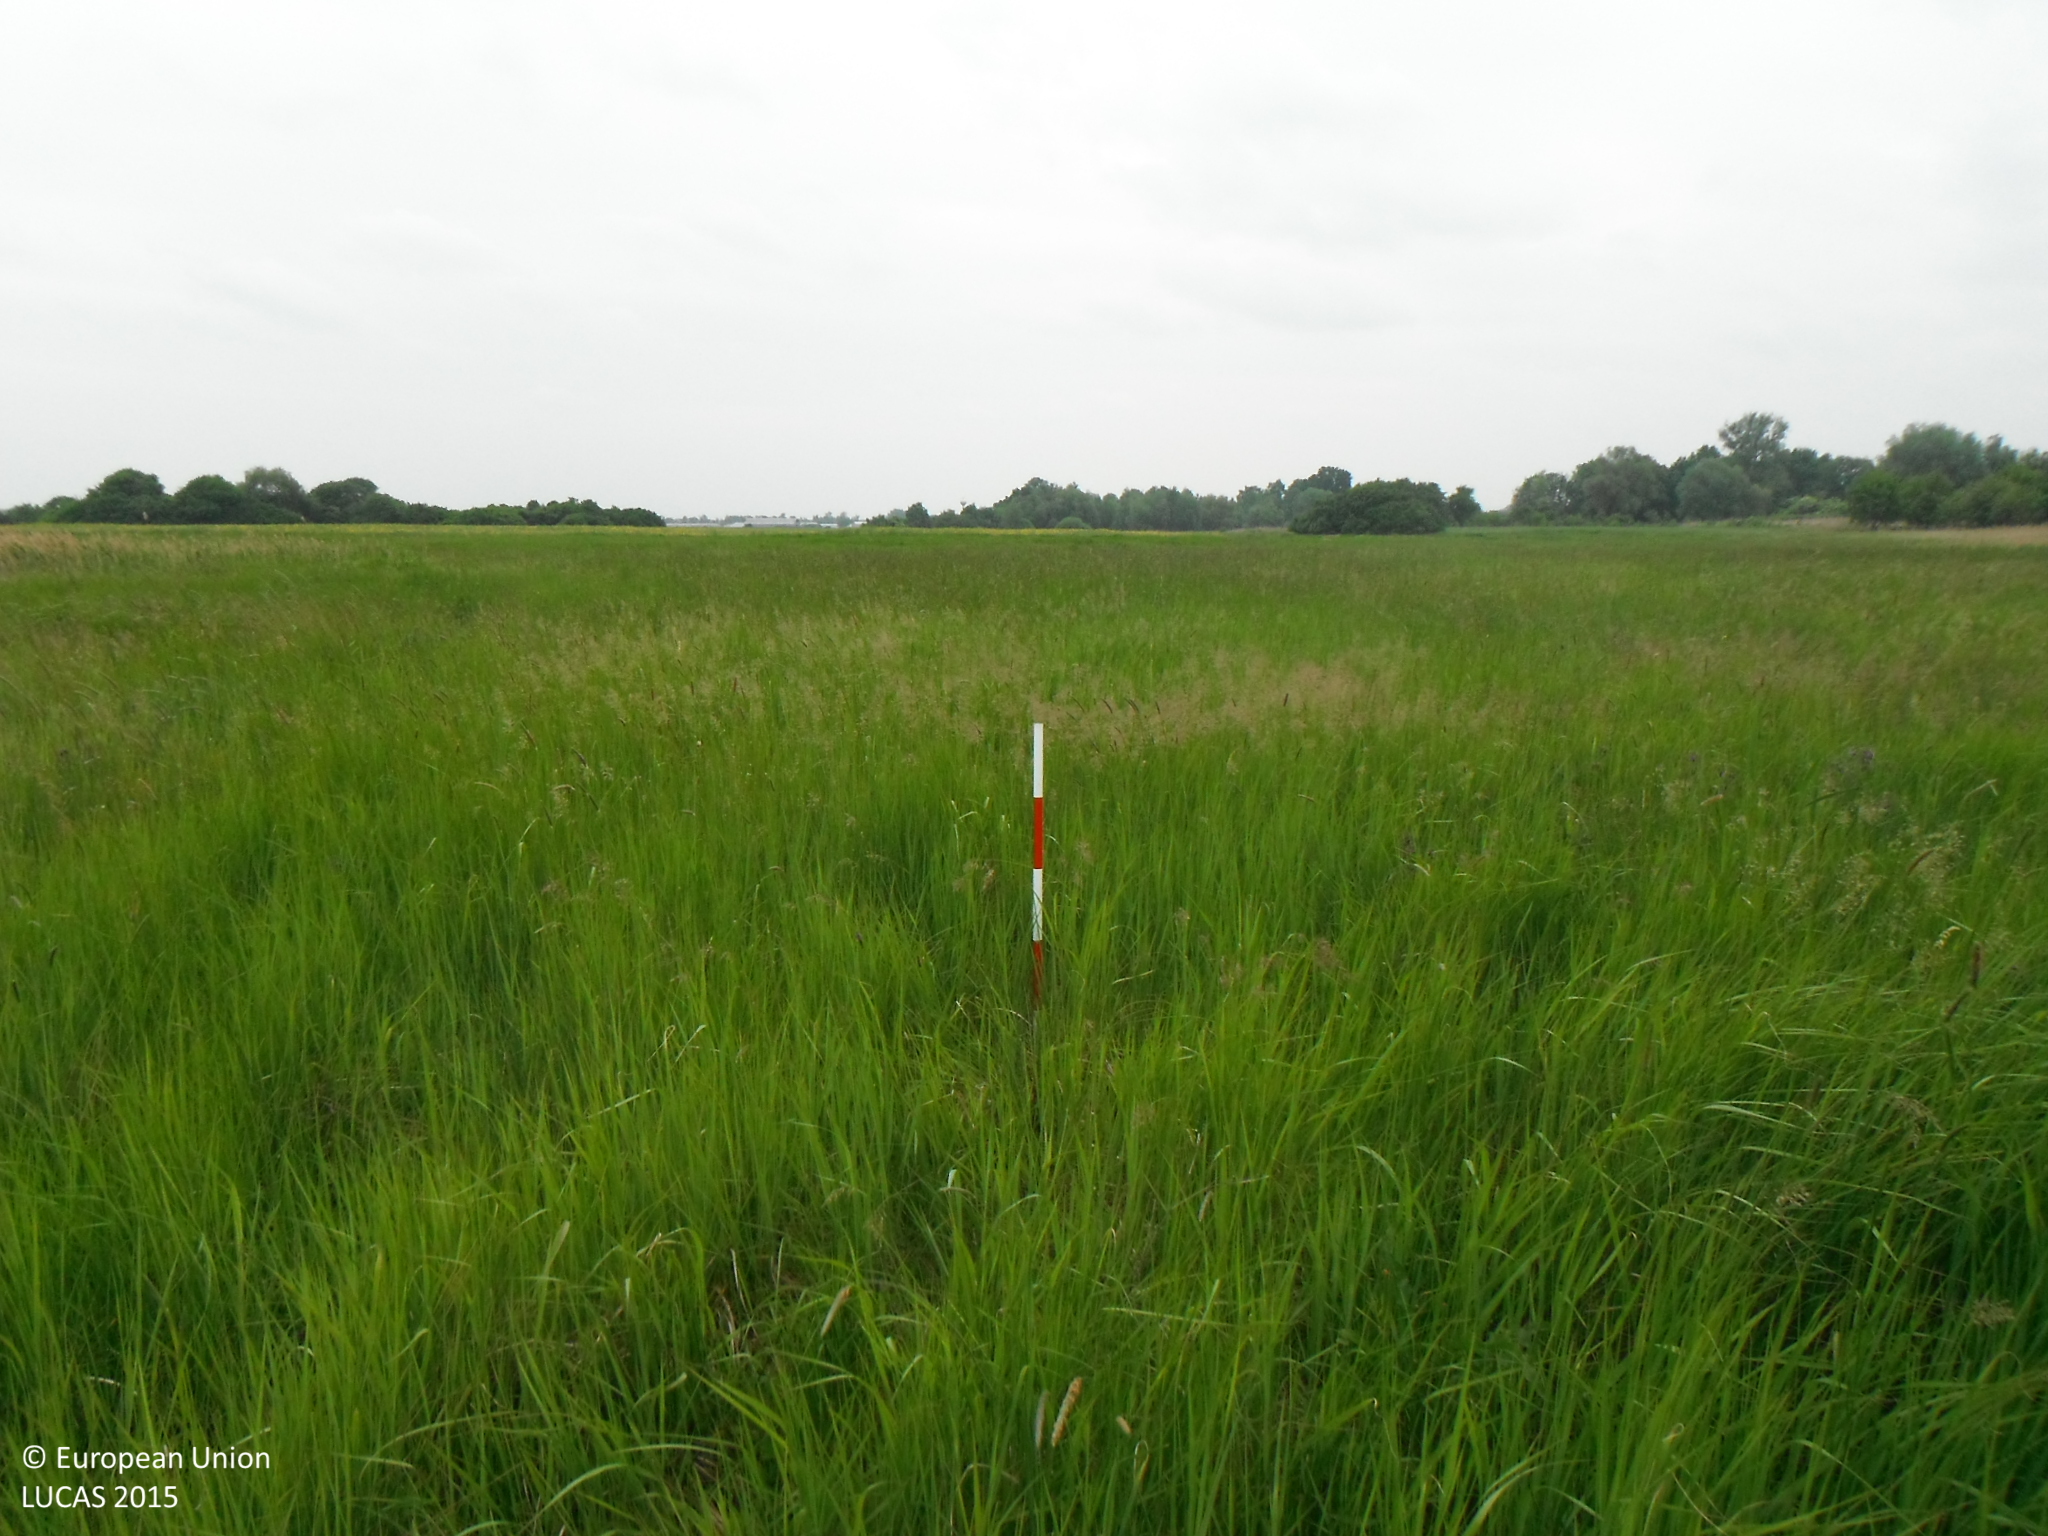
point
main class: Grassland
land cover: Spontaneously vegetated surfaces
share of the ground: > 75 %
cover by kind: herbaceous plants 100 %
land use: Abandoned areas
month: May
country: SK
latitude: 48.5795
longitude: 16.9890
